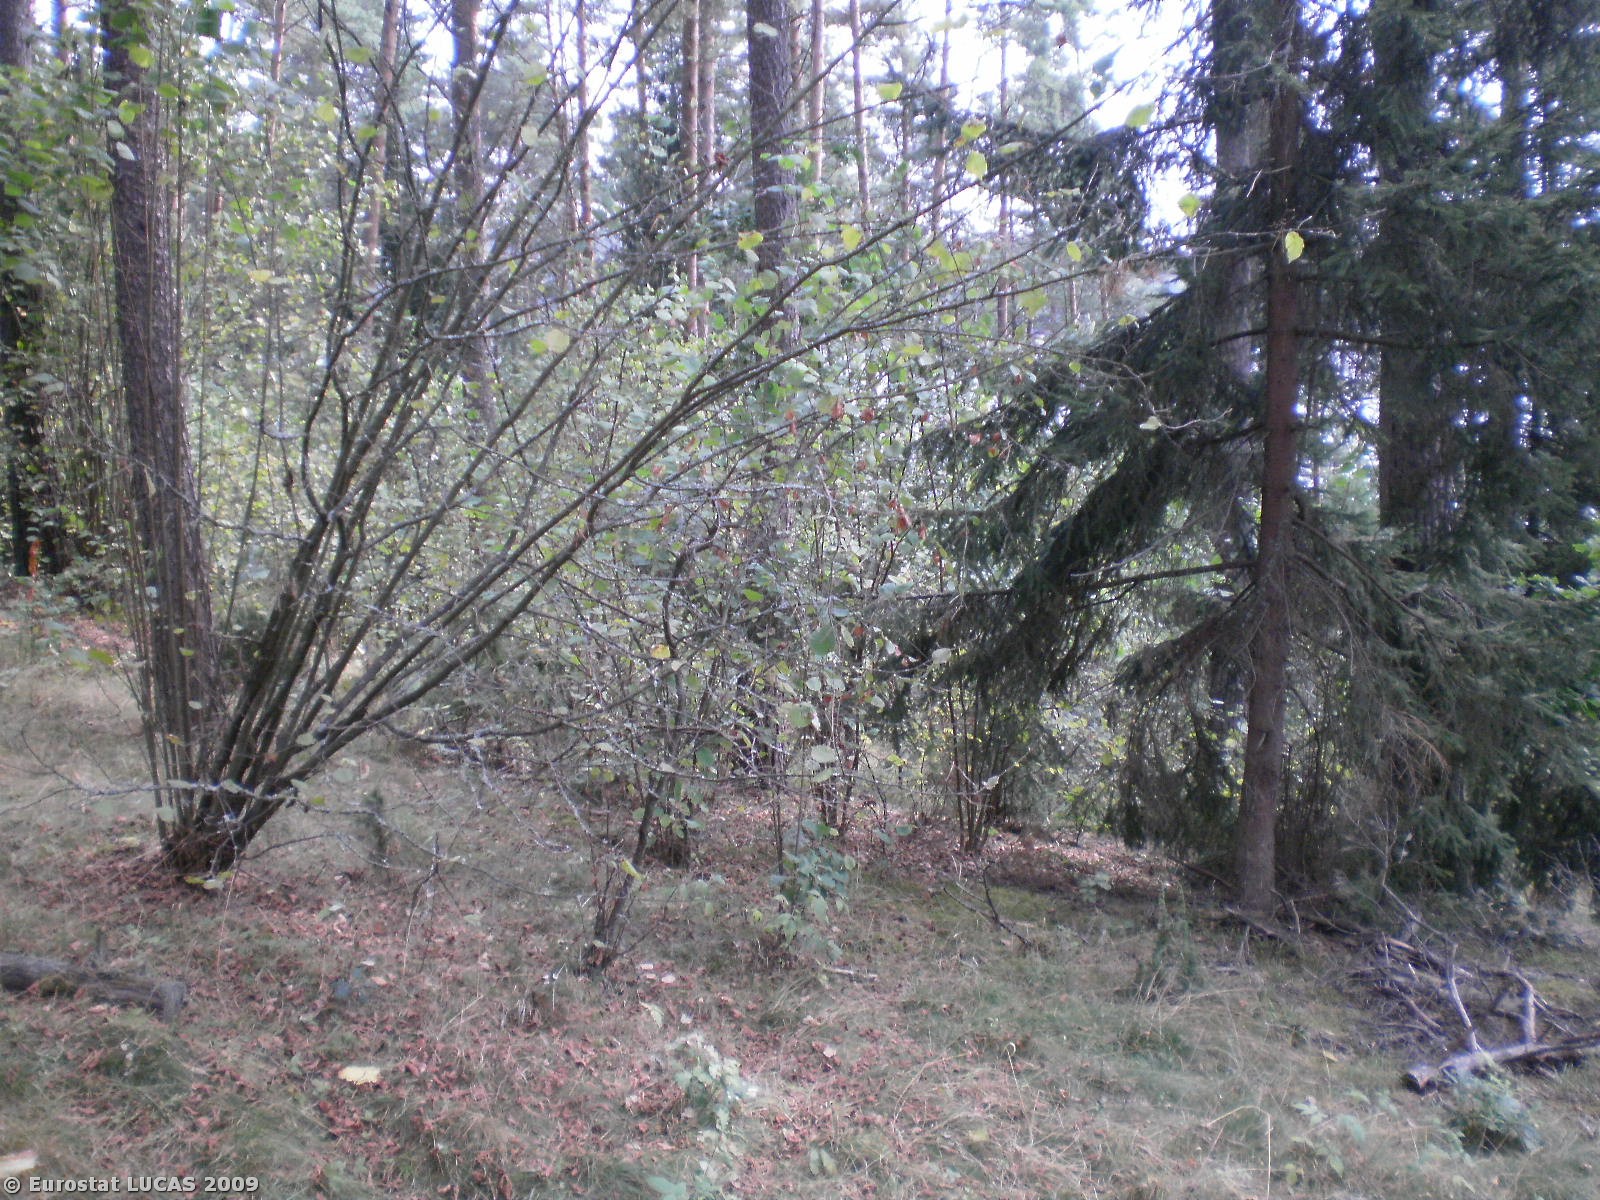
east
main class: Woodland
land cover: Coniferous woodland
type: hemiboreal forest and nemoral coniferous forest and mixed broadleaved-coniferous forest
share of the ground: 50 - 75 %
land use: Forestry
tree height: > 5 m
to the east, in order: Coniferous woodland; Tracks; Mixed woodland; Inland marshes; Inland water bodies
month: September
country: PL
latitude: 53.7156
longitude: 21.3976
